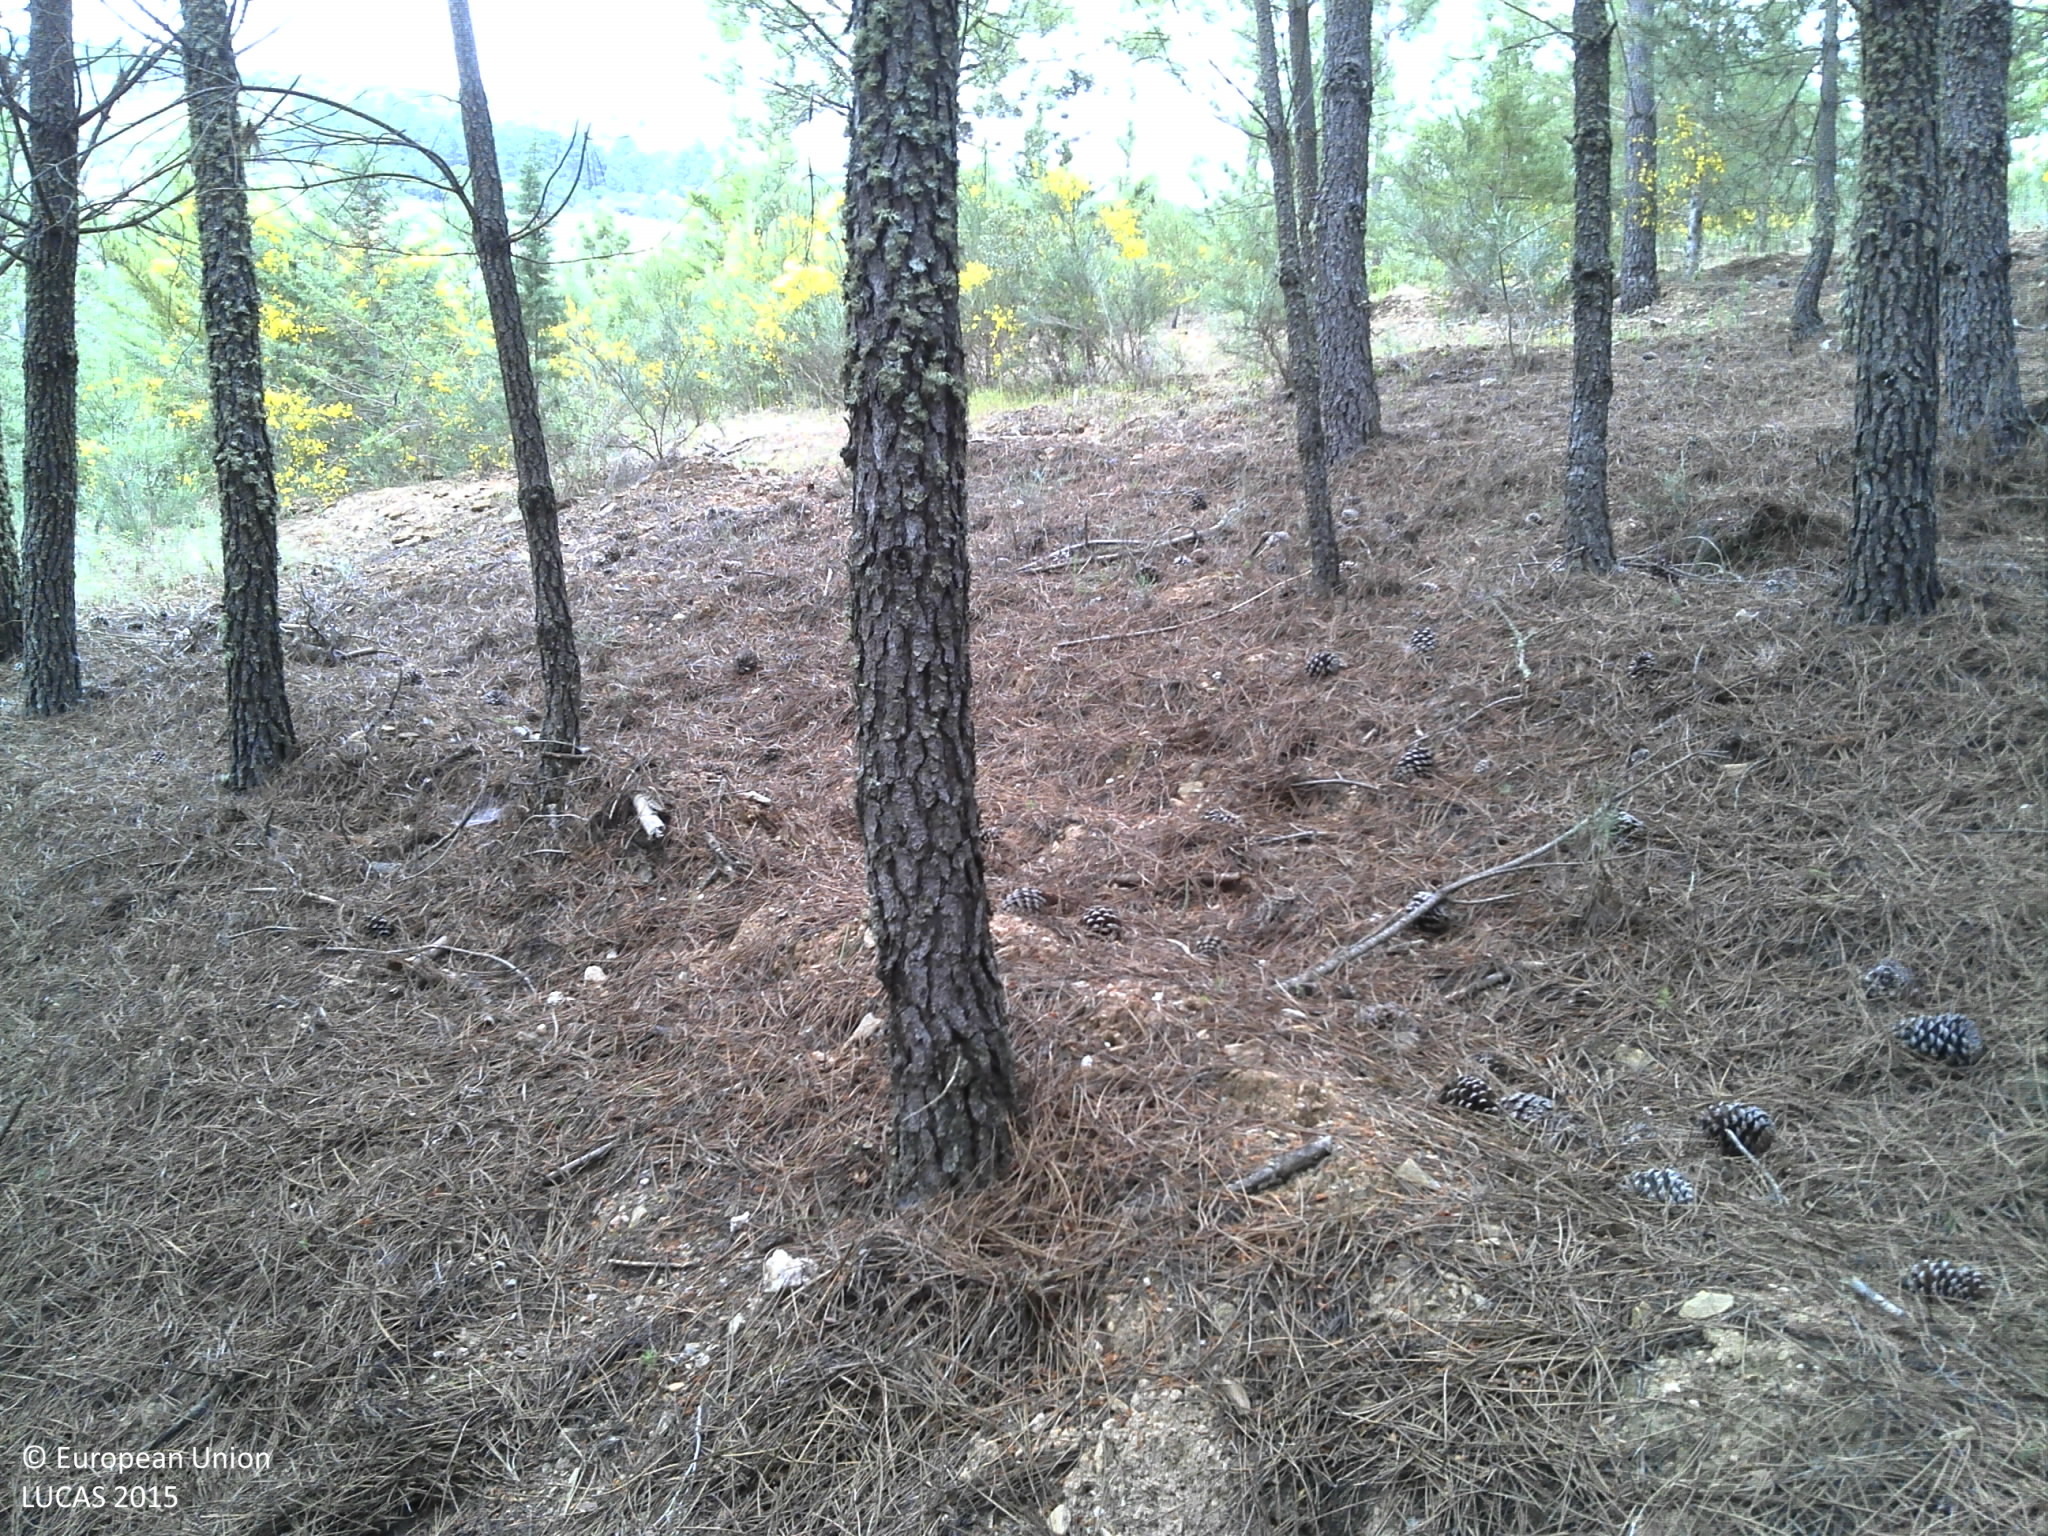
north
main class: Woodland
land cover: Pine dominated coniferous woodland
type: coniferous forest of the mediterranean region
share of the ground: 50 - 75 %
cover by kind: coniferous forest trees 75 %, unconsolidated bare surface 25 %
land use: Forestry
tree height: > 5 m
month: May
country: PT
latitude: 41.7596
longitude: -7.0917
